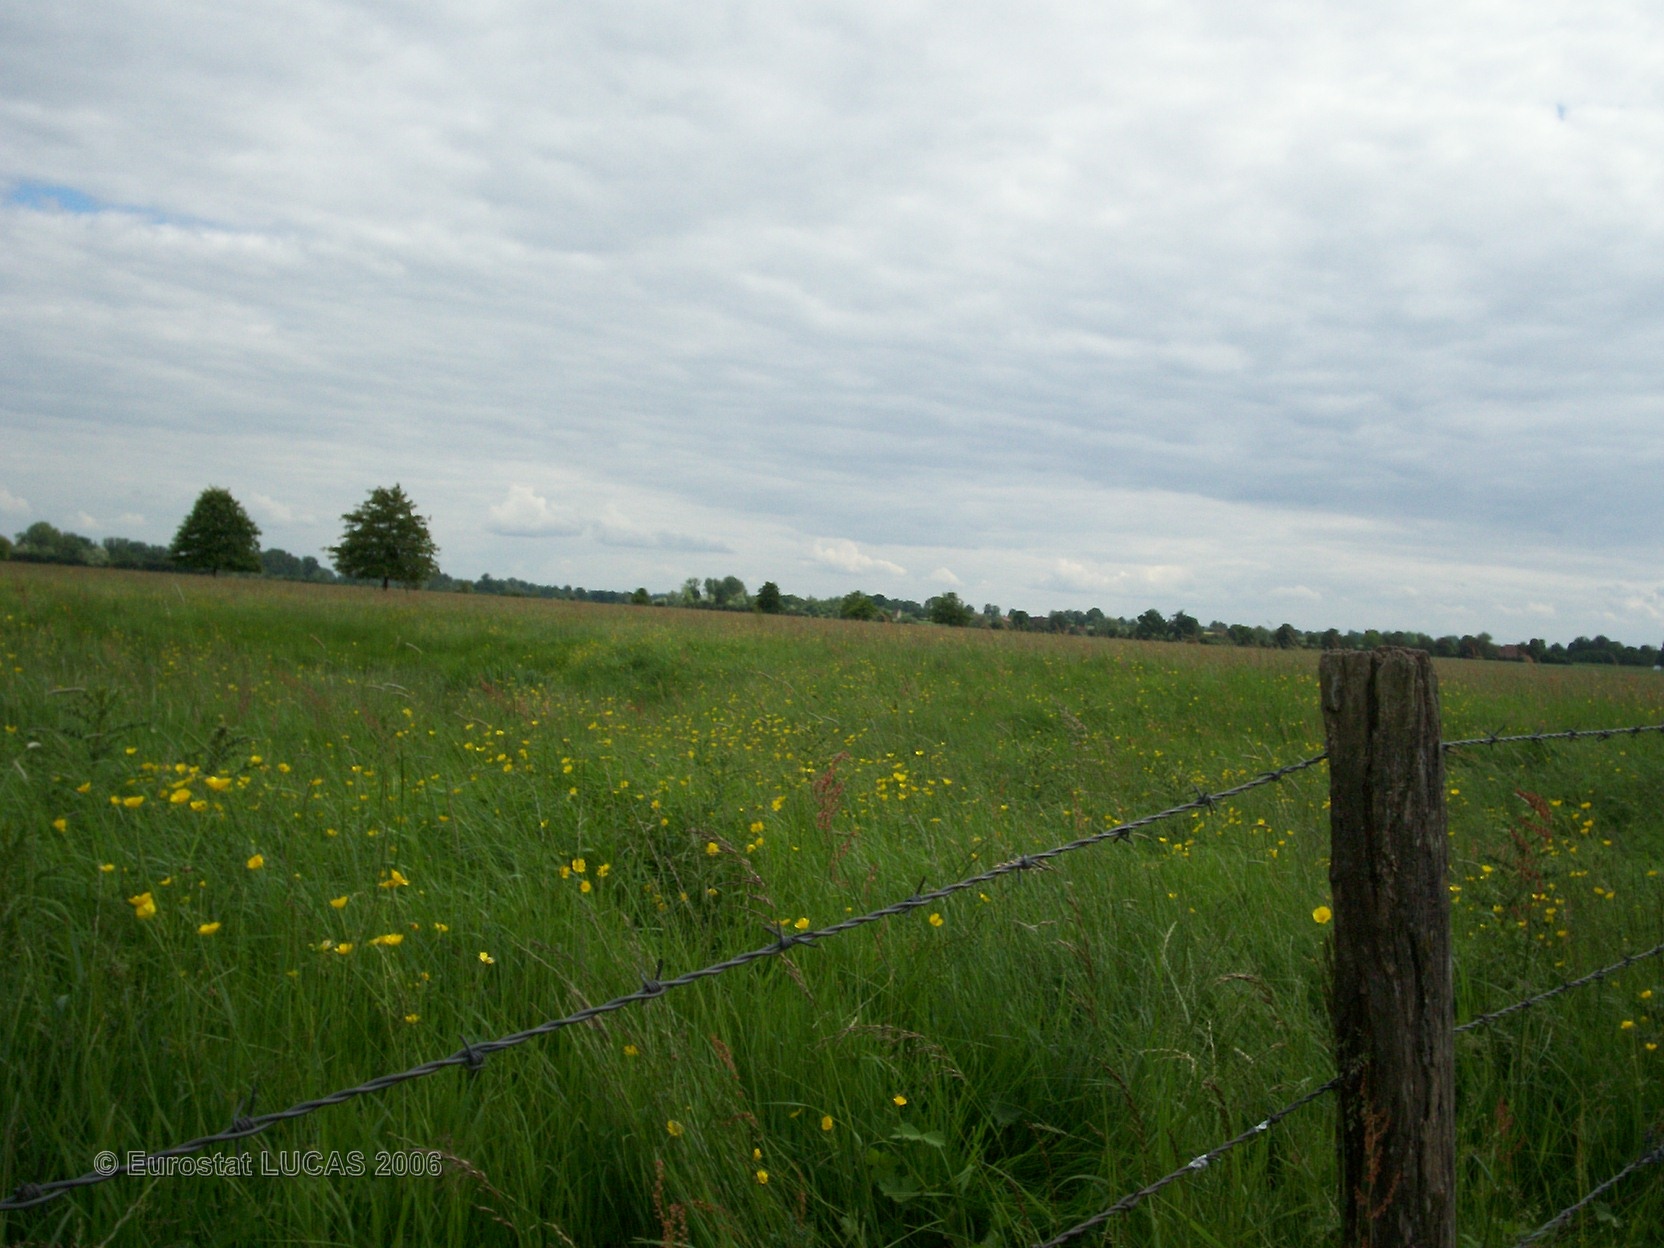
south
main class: Grassland
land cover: Grassland without tree/shrub cover
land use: Agriculture (excluding fallow land and kitchen gardens)
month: May
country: FR
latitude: 46.9023
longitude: 3.0518
